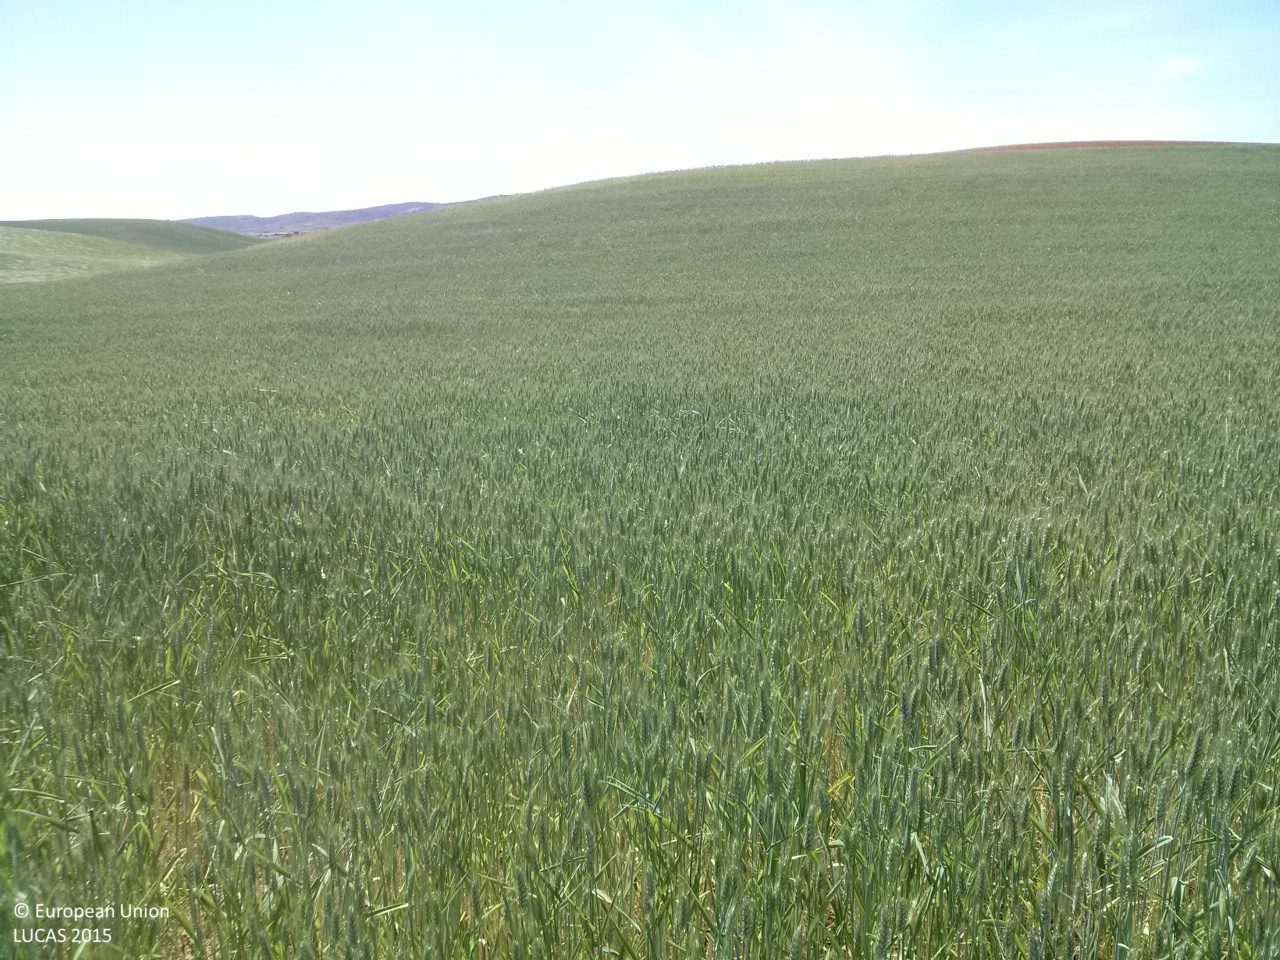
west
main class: Cropland
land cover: Common wheat
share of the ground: > 75 %
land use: Agriculture (excluding fallow land and kitchen gardens)
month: May
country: ES
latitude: 40.1410
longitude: -2.7816
